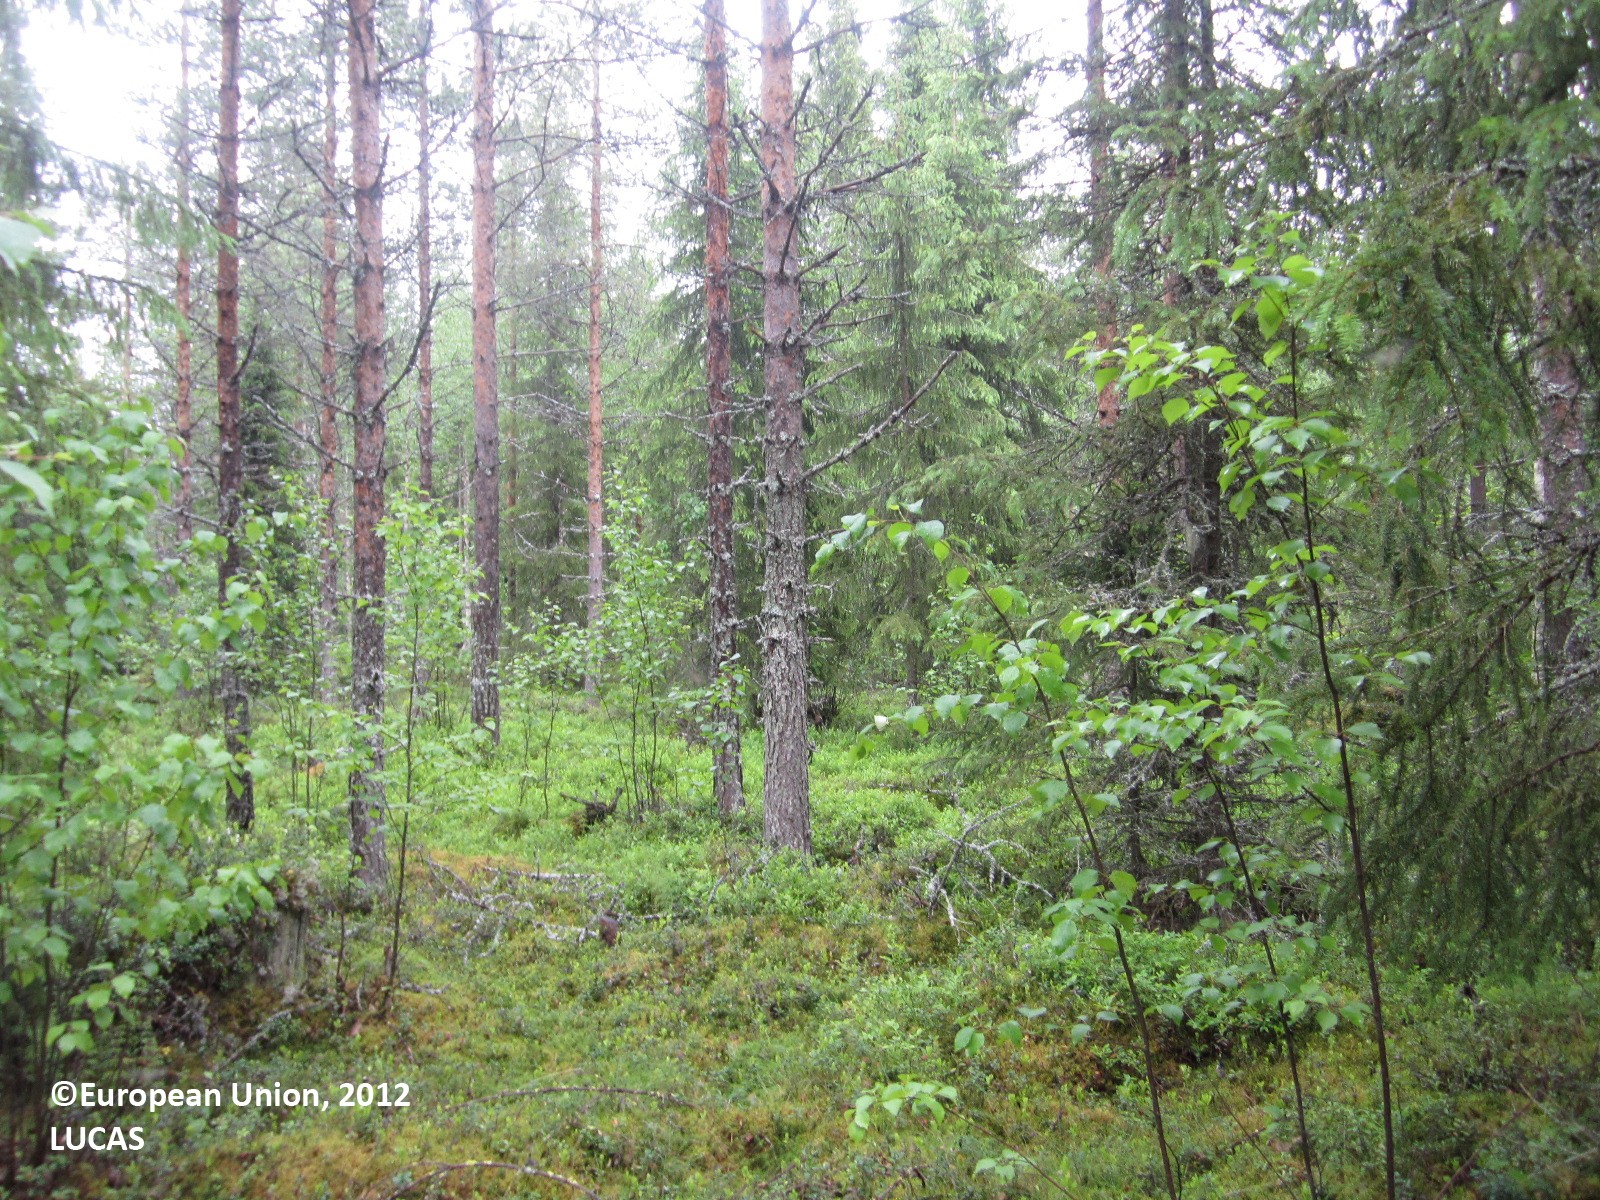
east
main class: Woodland
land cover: Other mixed woodland
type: boreal forest
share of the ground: > 75 %
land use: Forestry
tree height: > 5 m
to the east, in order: Other mixed woodland; Spruce dominated mixed woodland; Ditches and canals; Pine dominated mixed woodland; Ditches and canals; Pine dominated mixed woodland; Ditches and canals; Spontaneously vegetated surfaces; Paved roads, cycling and walking lanes; Spontaneously vegetated surfaces; Ditches and canals; Spontaneously vegetated surfaces; Shrubland with sparse tree cover; Ditches and canals; Shrubland with sparse tree cover; Spontaneously vegetated surfaces; Pine dominated mixed woodland; Ditches and canals; Pine dominated mixed woodland; Ditches and canals; Pine dominated mixed woodland
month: June
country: FI
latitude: 64.5887
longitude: 29.2289
